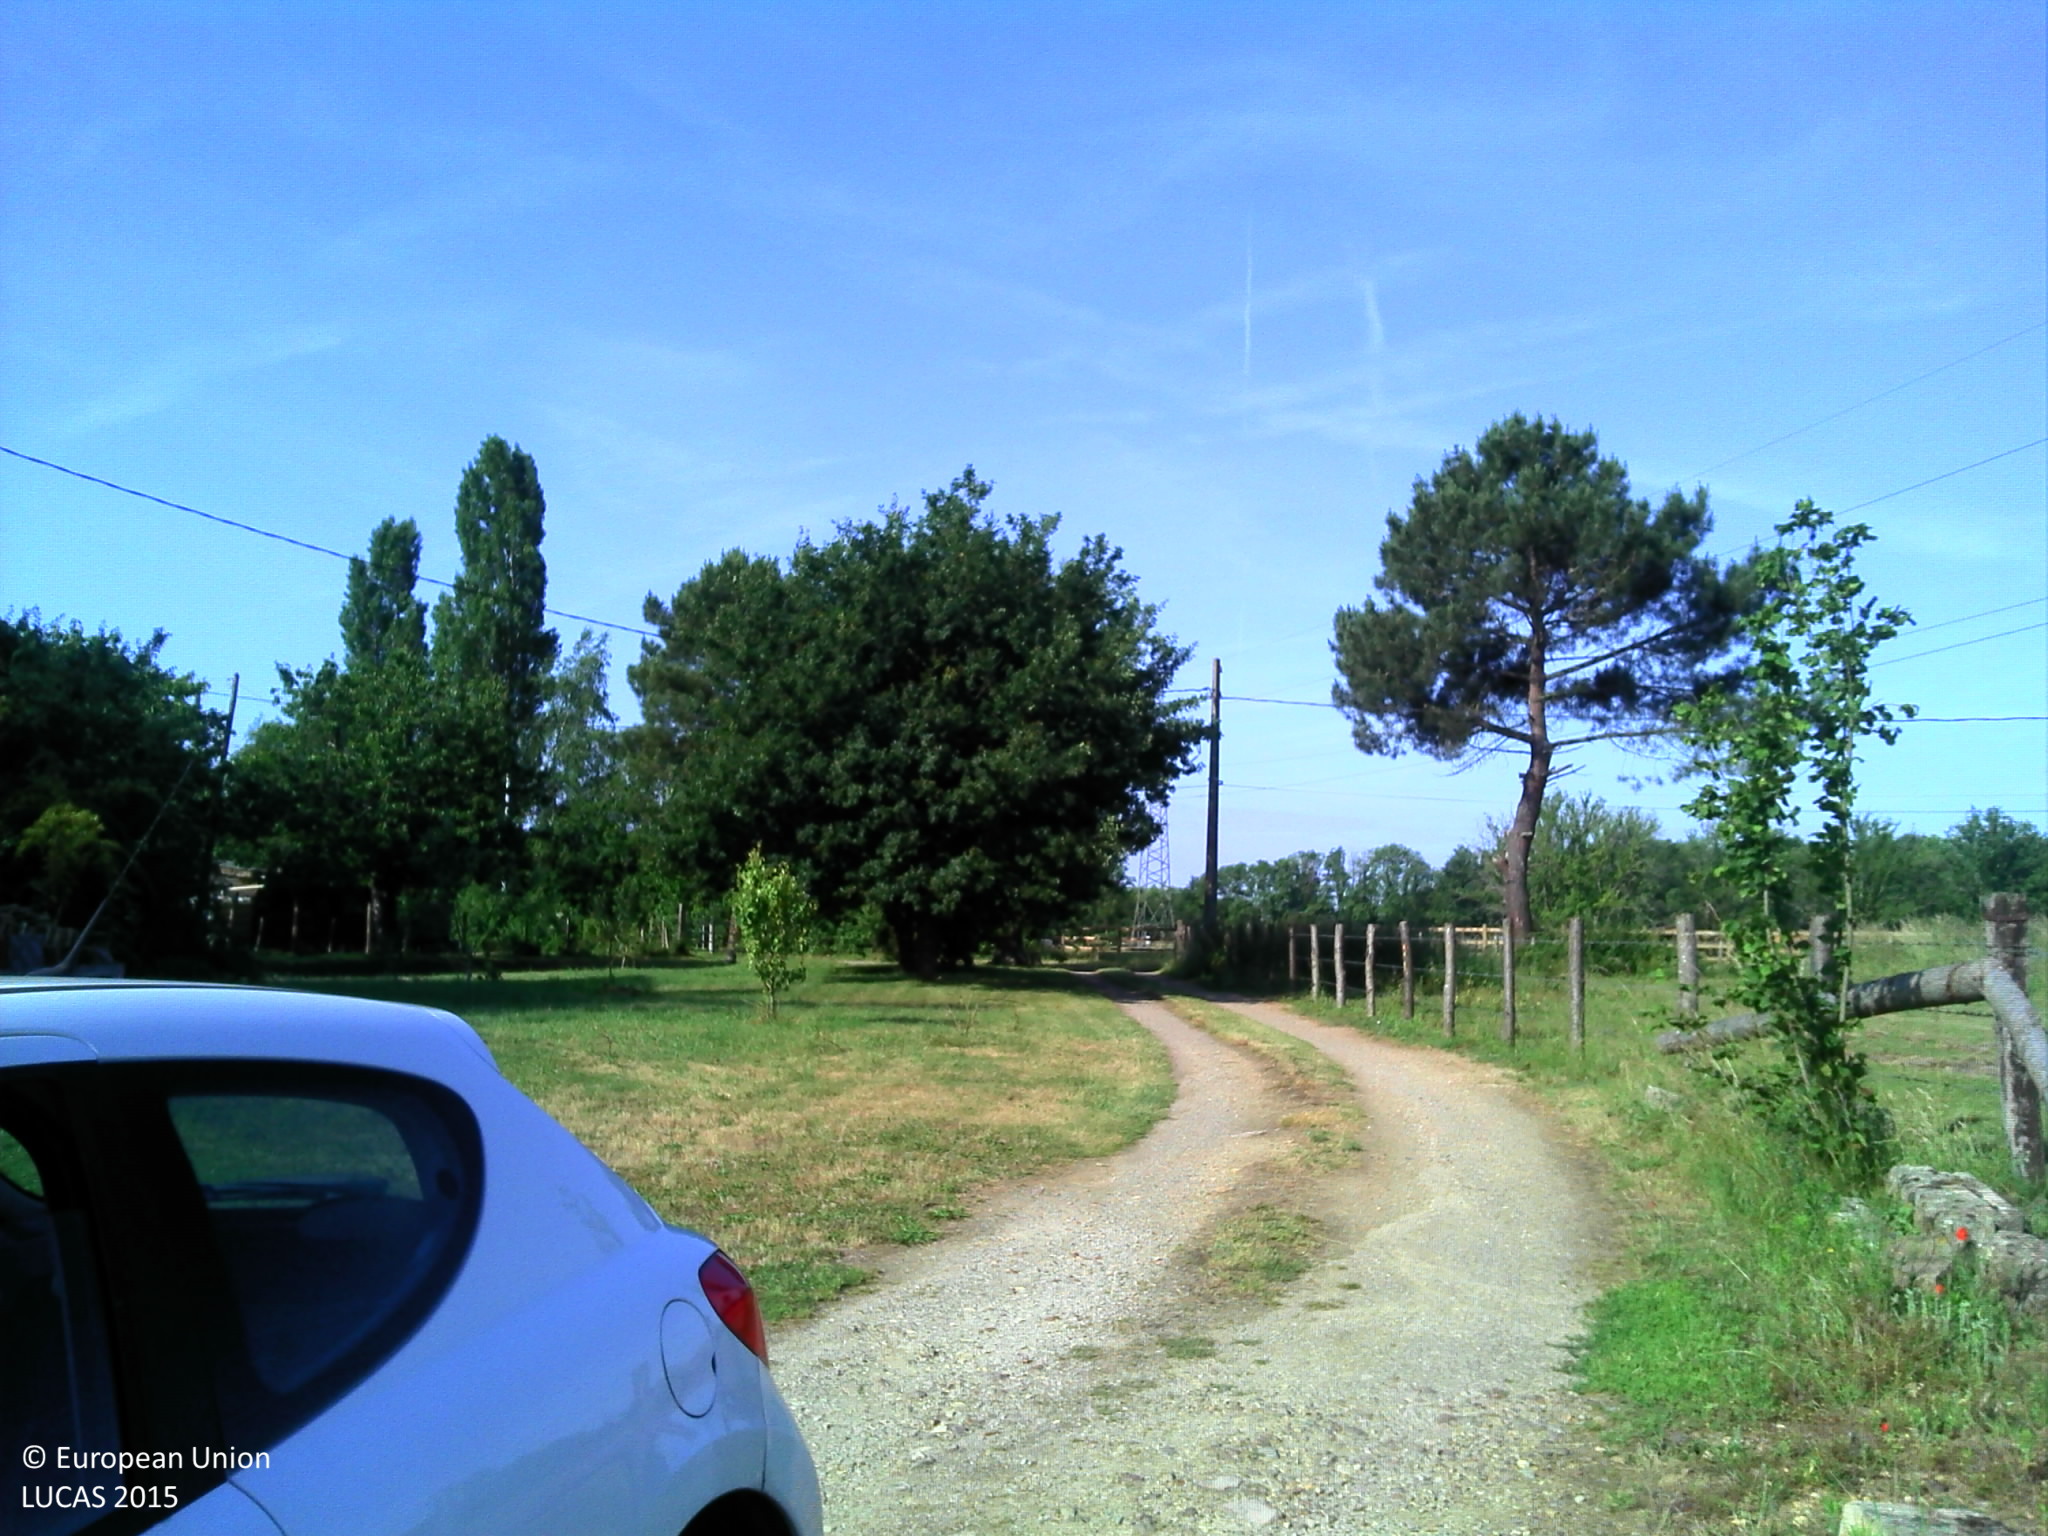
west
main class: Grassland
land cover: Grassland without tree/shrub cover
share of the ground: > 75 %
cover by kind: herbaceous plants 100 %
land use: Agriculture (excluding fallow land and kitchen gardens)
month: June
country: FR
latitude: 48.0488
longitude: 0.3024
